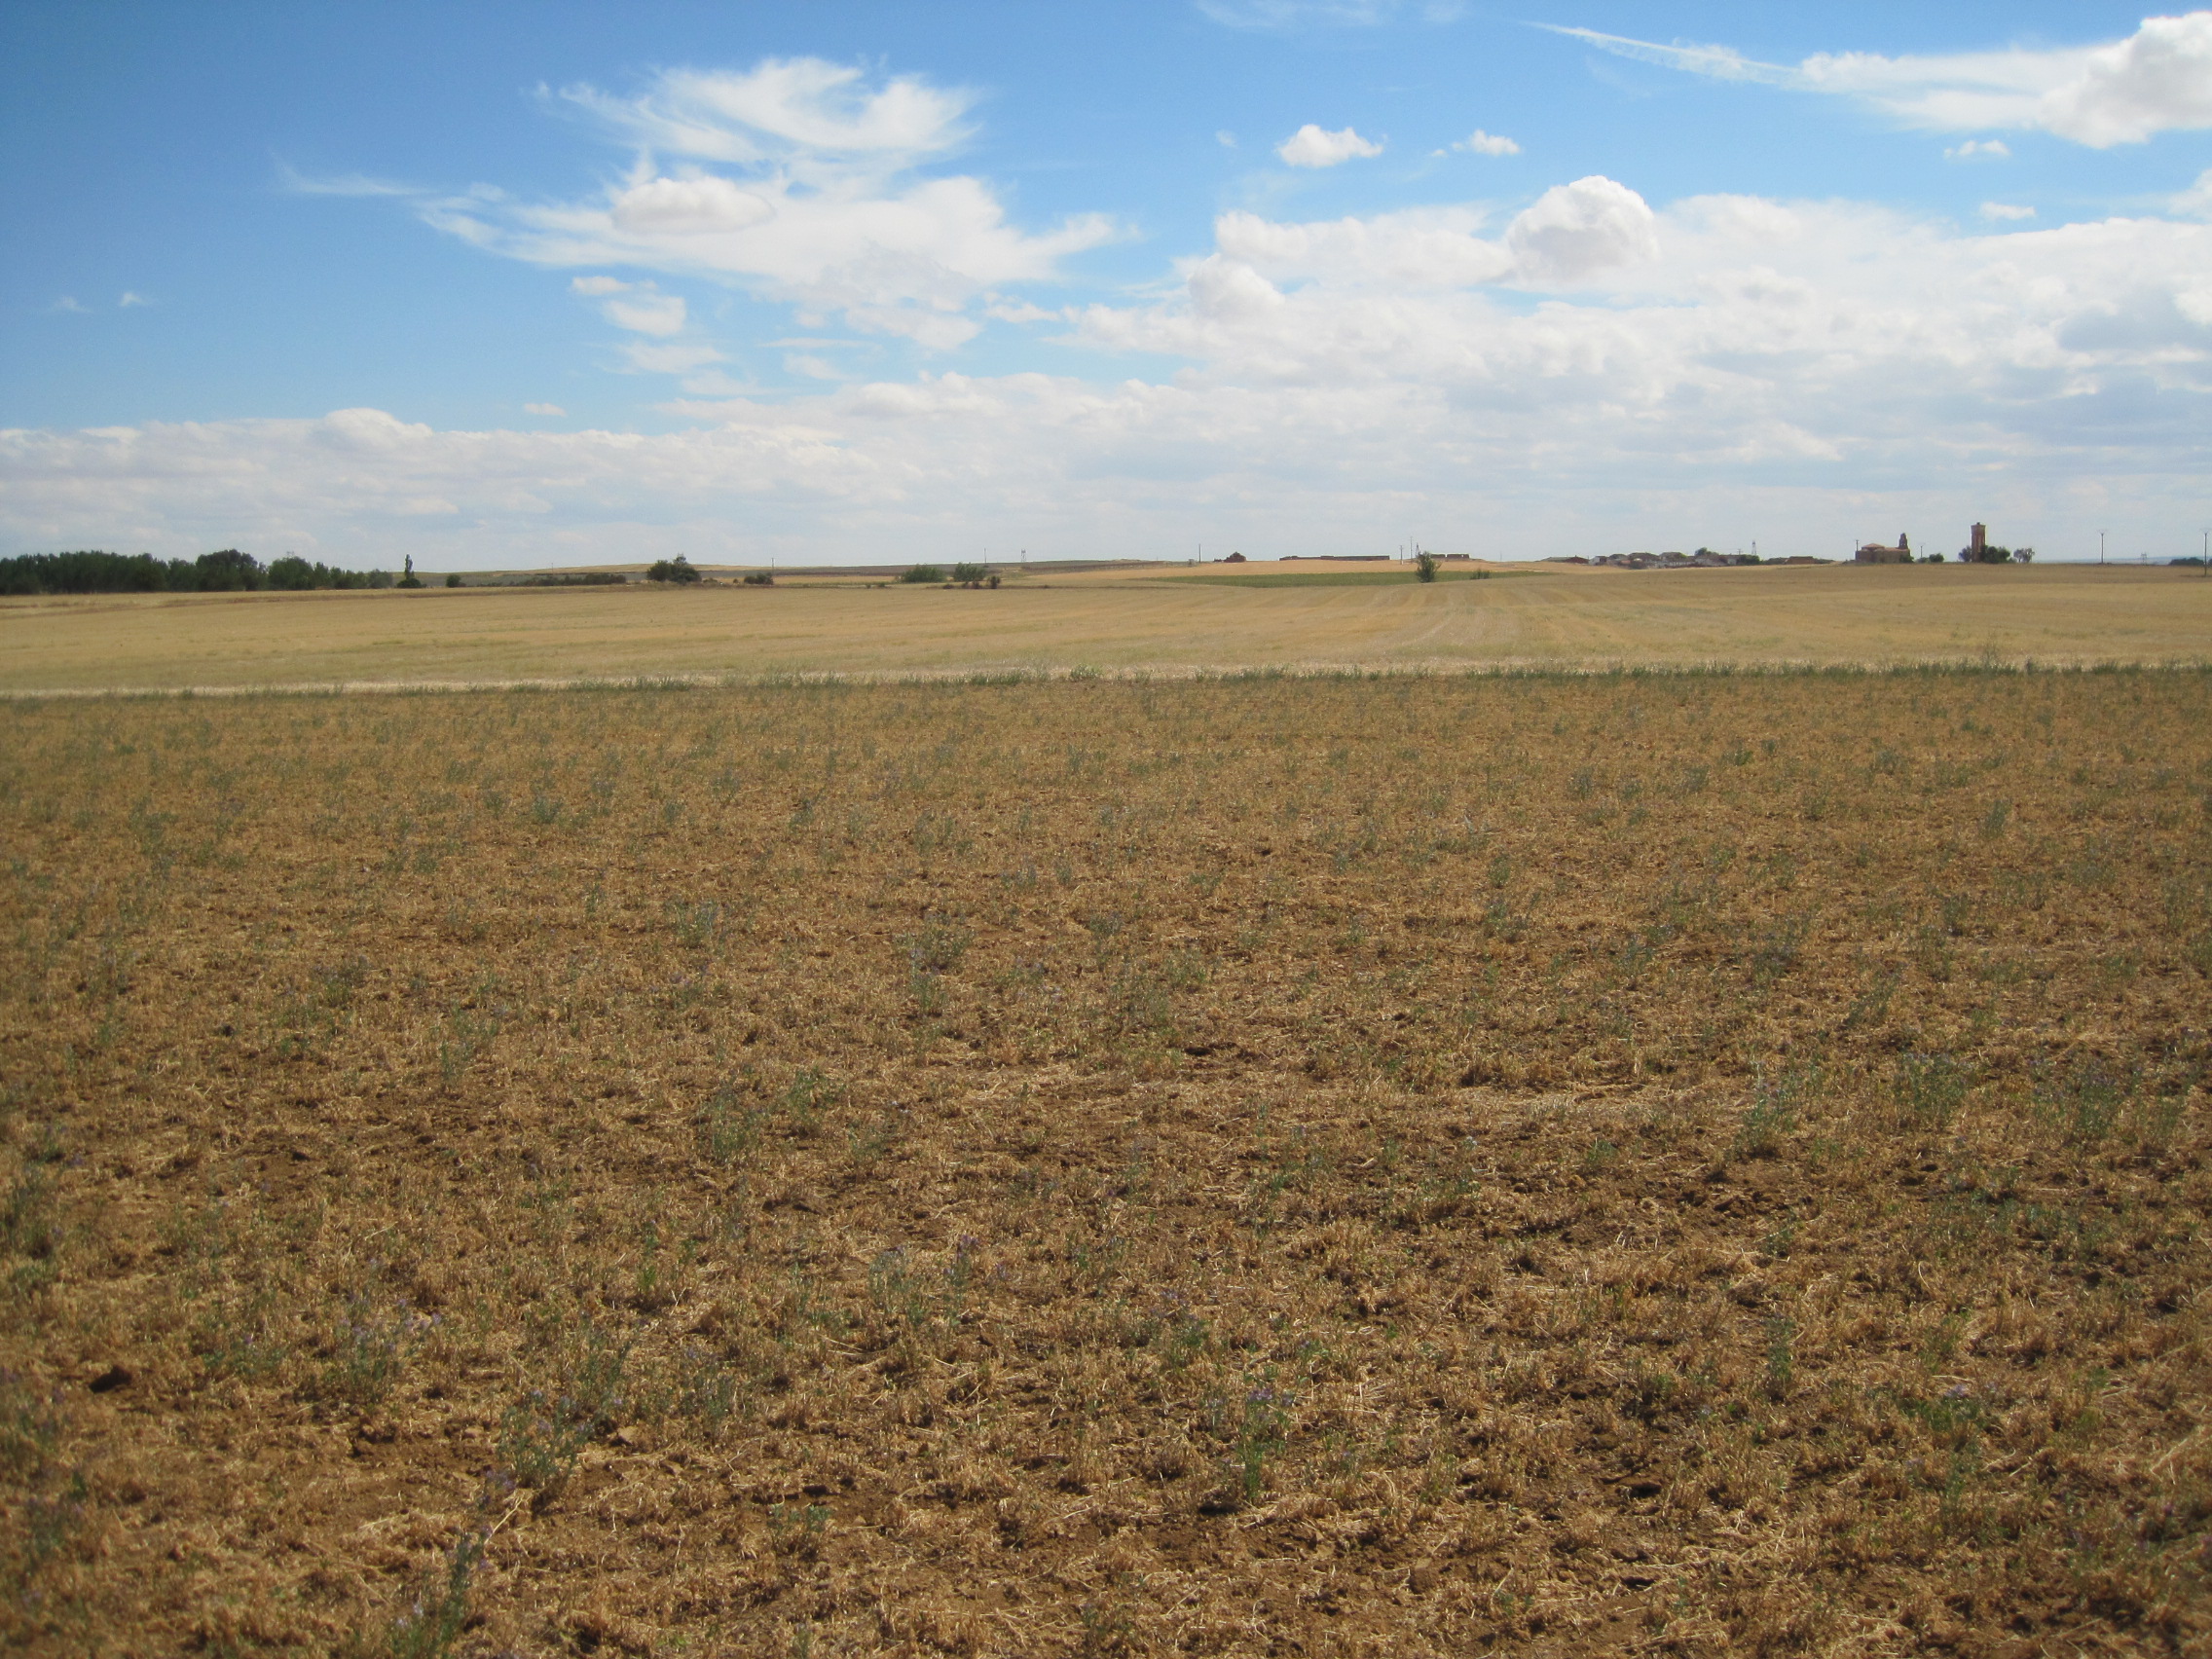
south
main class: Cropland
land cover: Lucerne
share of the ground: 25 - 50 %
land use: Agriculture (excluding fallow land and kitchen gardens)
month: July
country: ES
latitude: 41.9579
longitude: -5.1989
